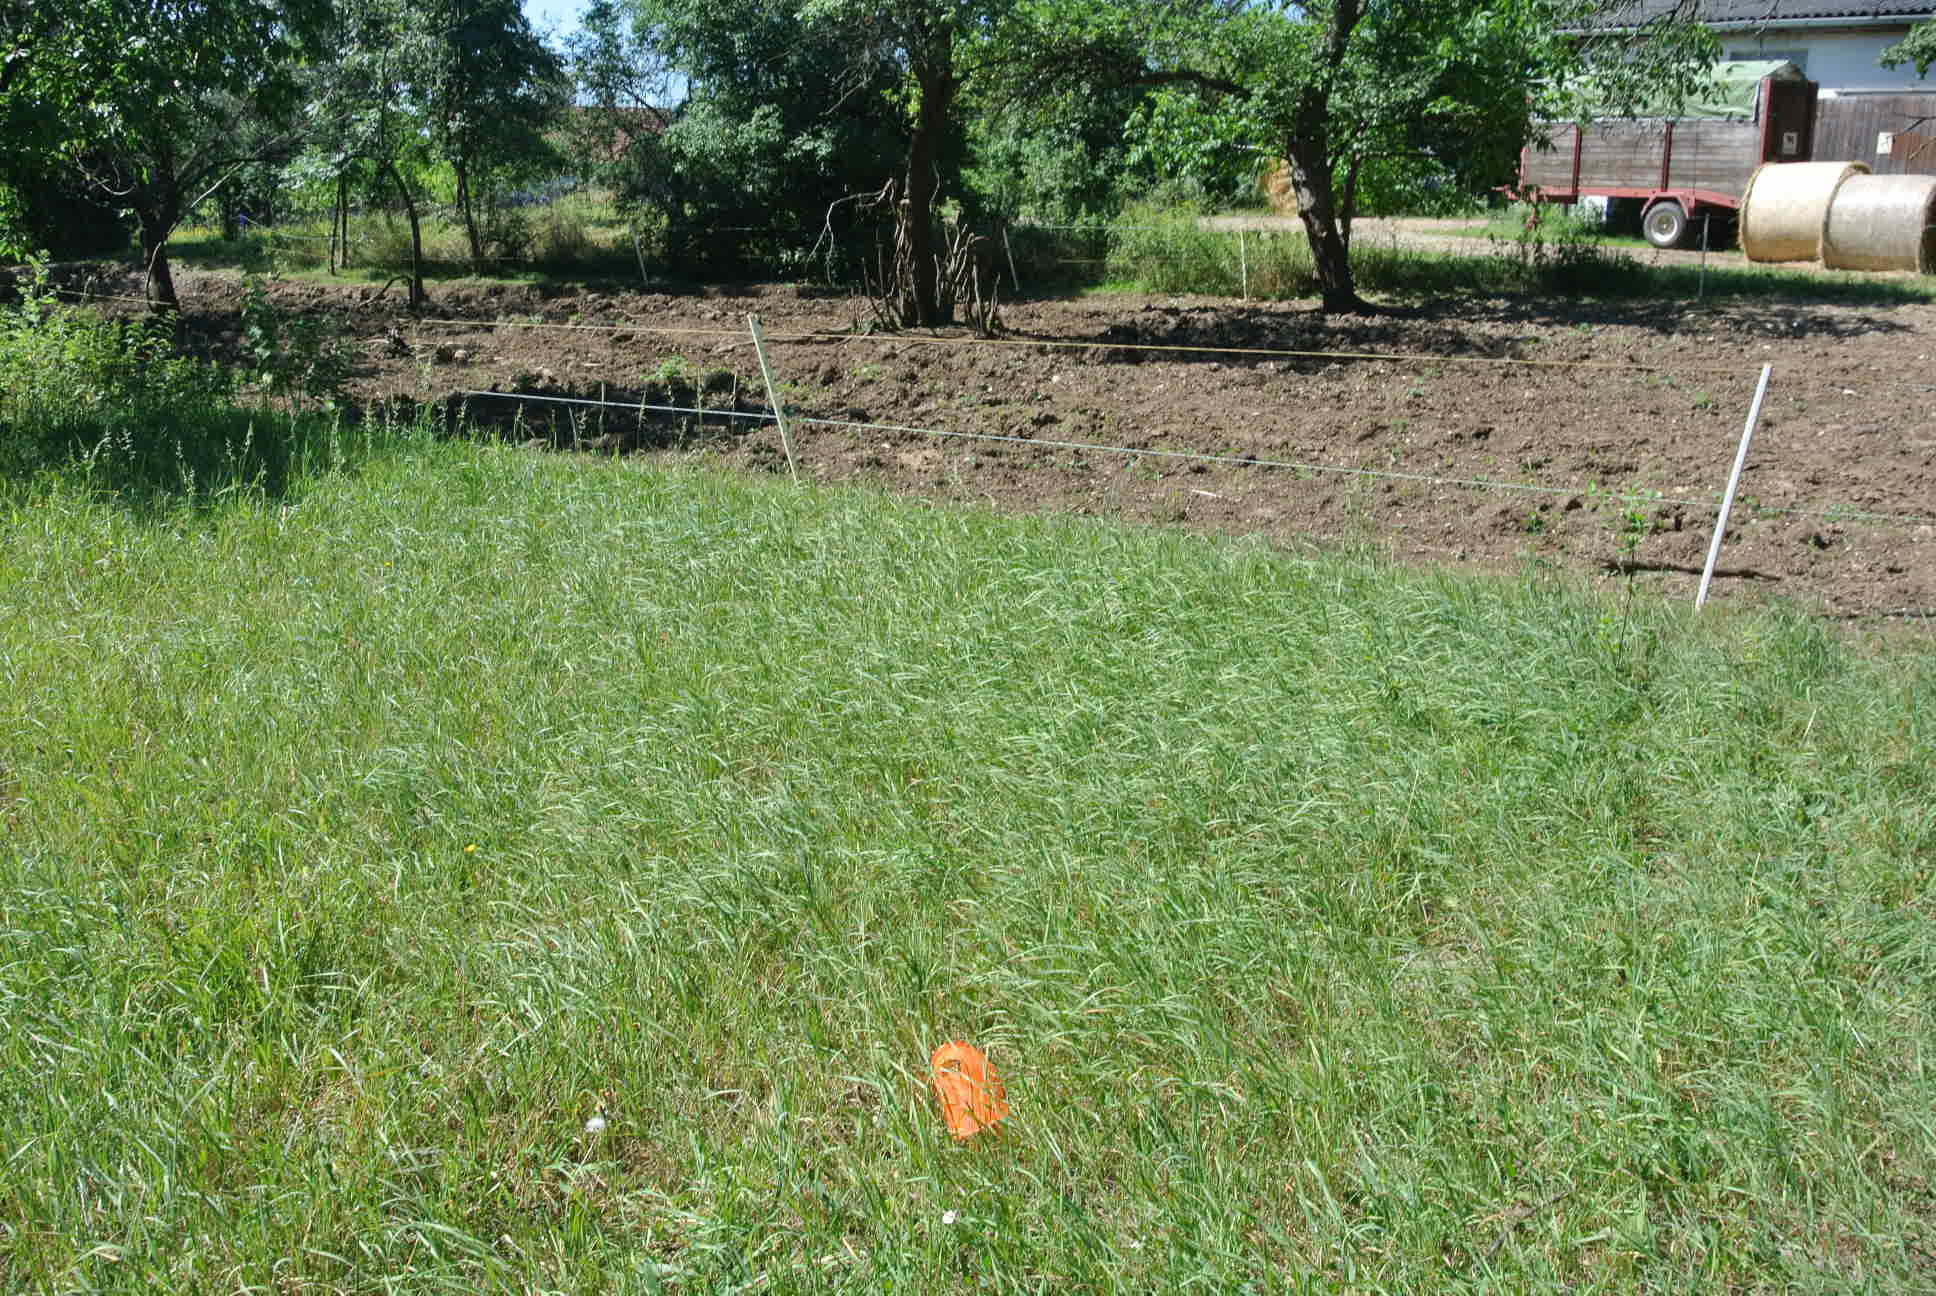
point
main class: Grassland
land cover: Grassland with sparse tree/shrub cover
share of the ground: > 75 %
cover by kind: herbaceous plants 90 %, broadleaved forest trees 5 %, shrubs 5 %
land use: Agriculture (excluding fallow land and kitchen gardens)
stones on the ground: < 10 %
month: July
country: AT
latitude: 47.7688
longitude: 16.0475
